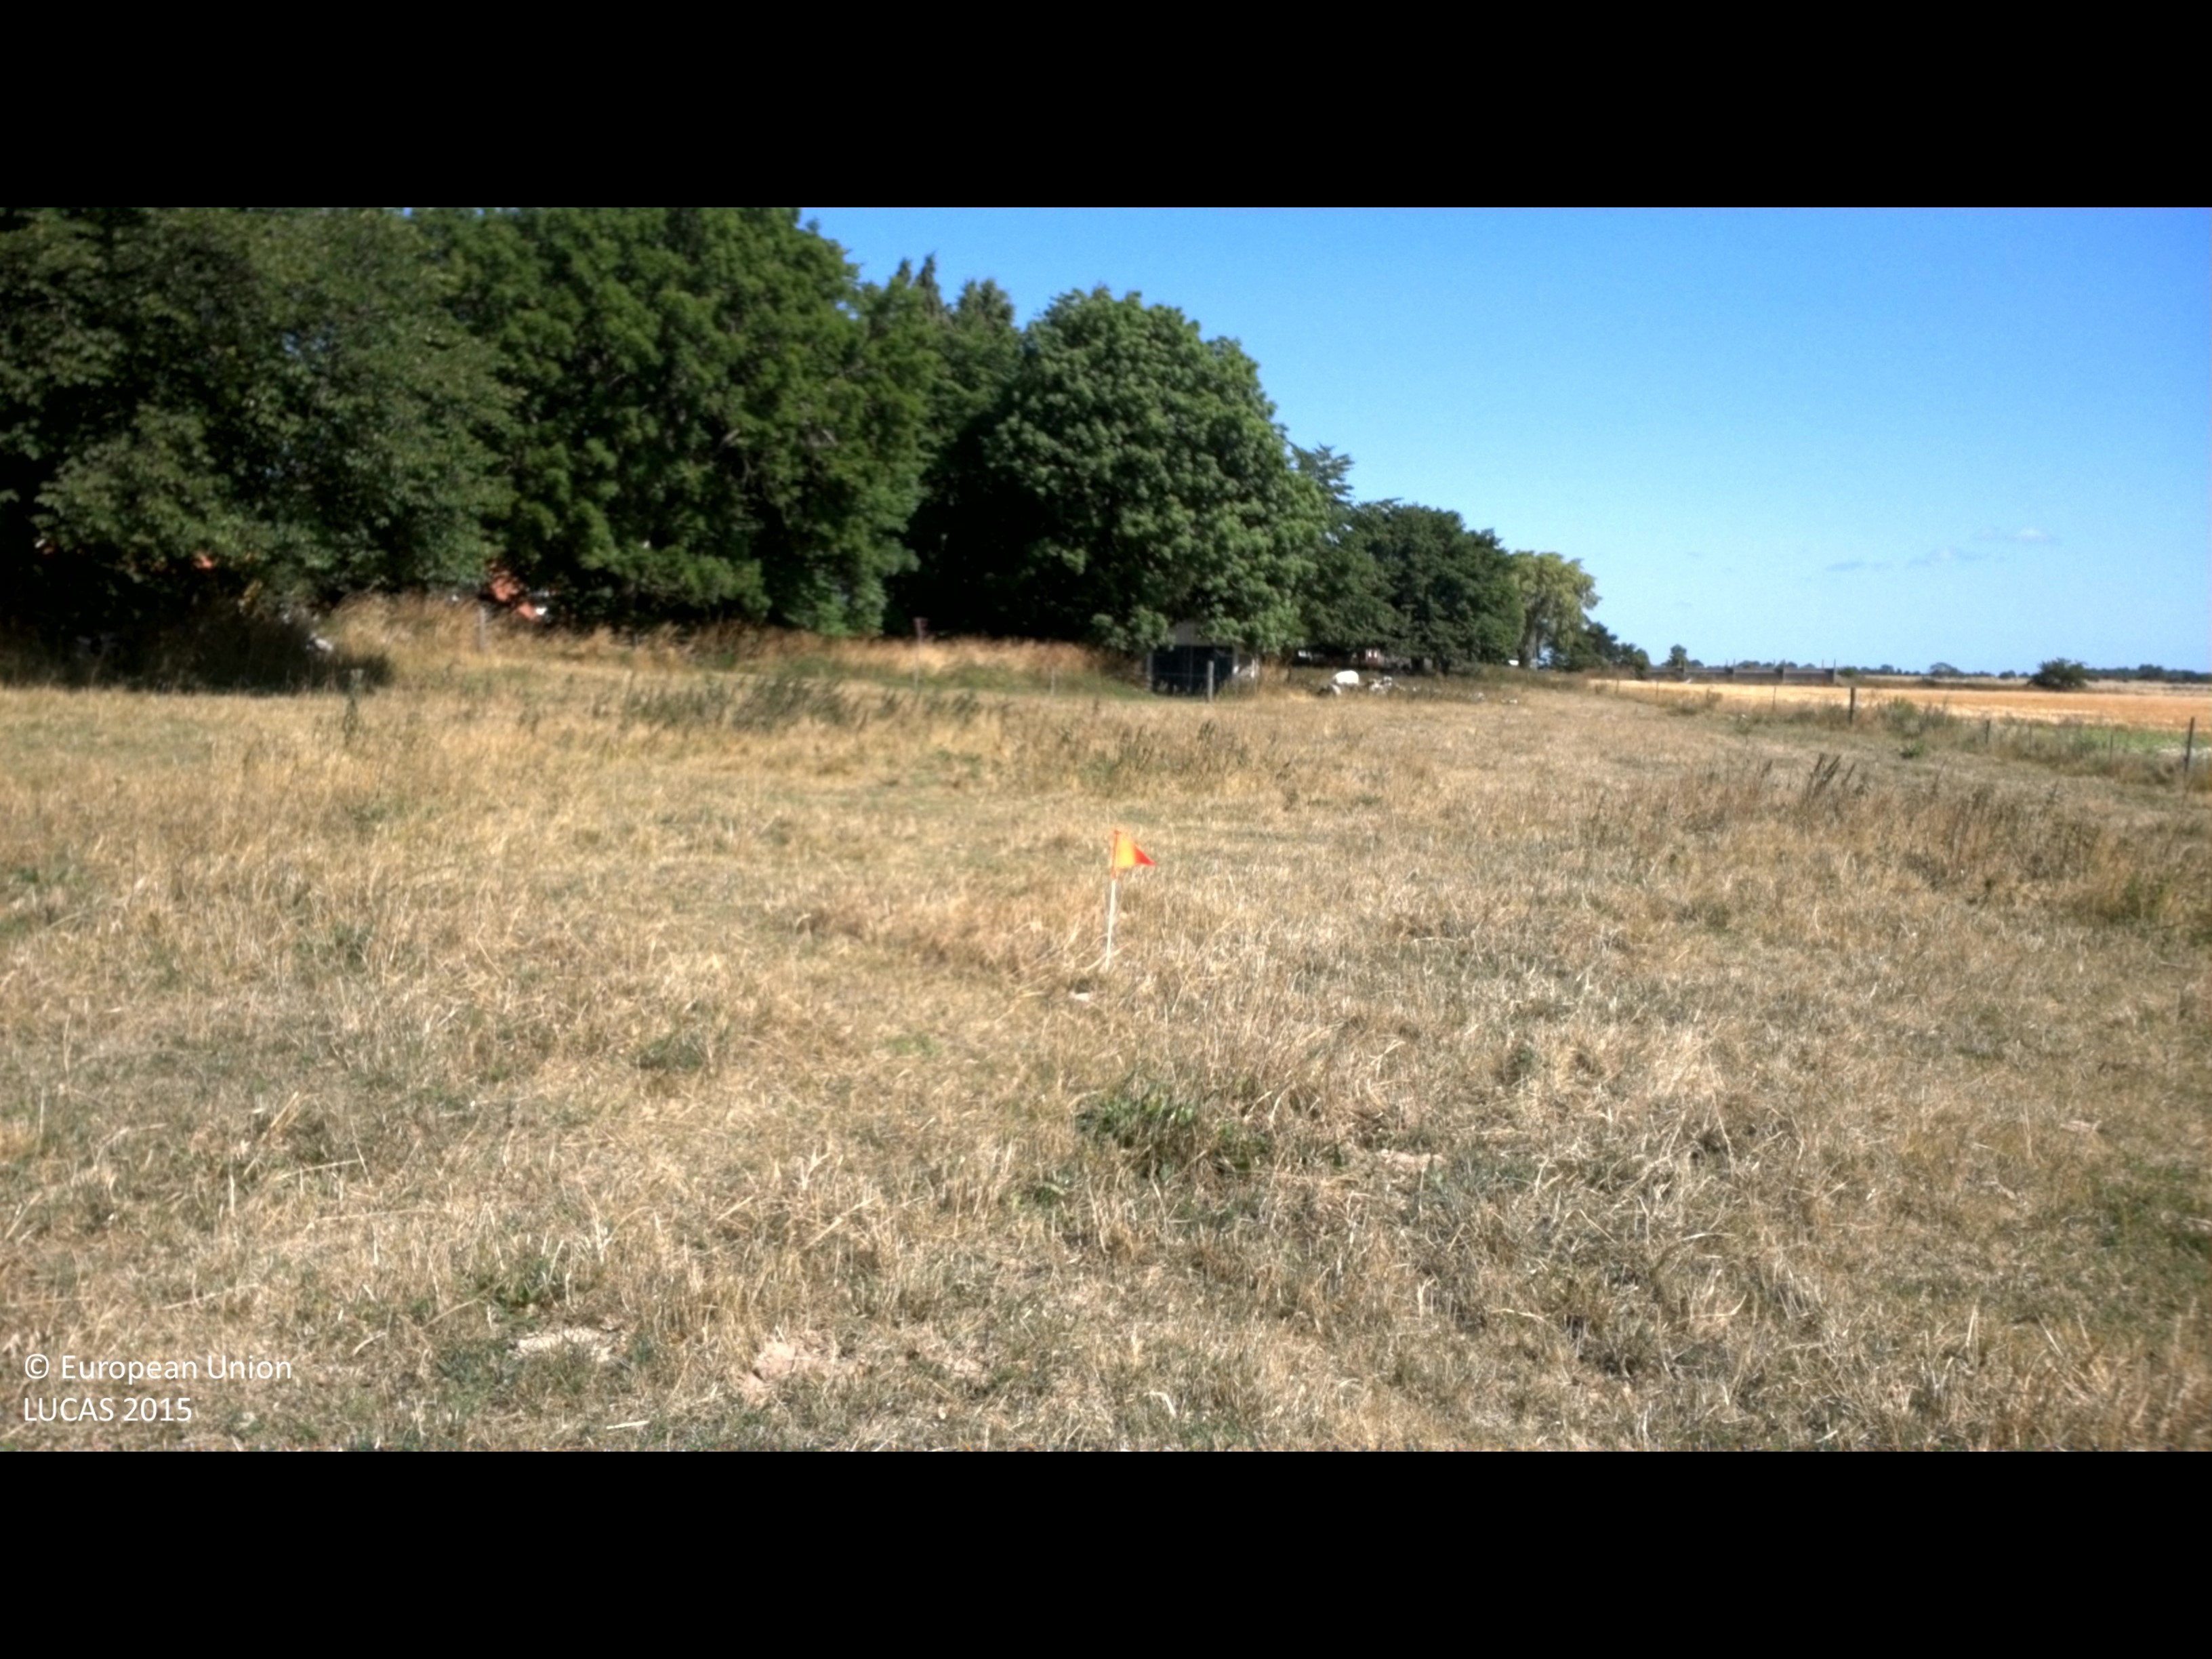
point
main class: Grassland
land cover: Grassland without tree/shrub cover
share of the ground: > 75 %
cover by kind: herbaceous plants 100 %
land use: Agriculture (excluding fallow land and kitchen gardens)
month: July
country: SE
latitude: 56.2588
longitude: 16.4756
